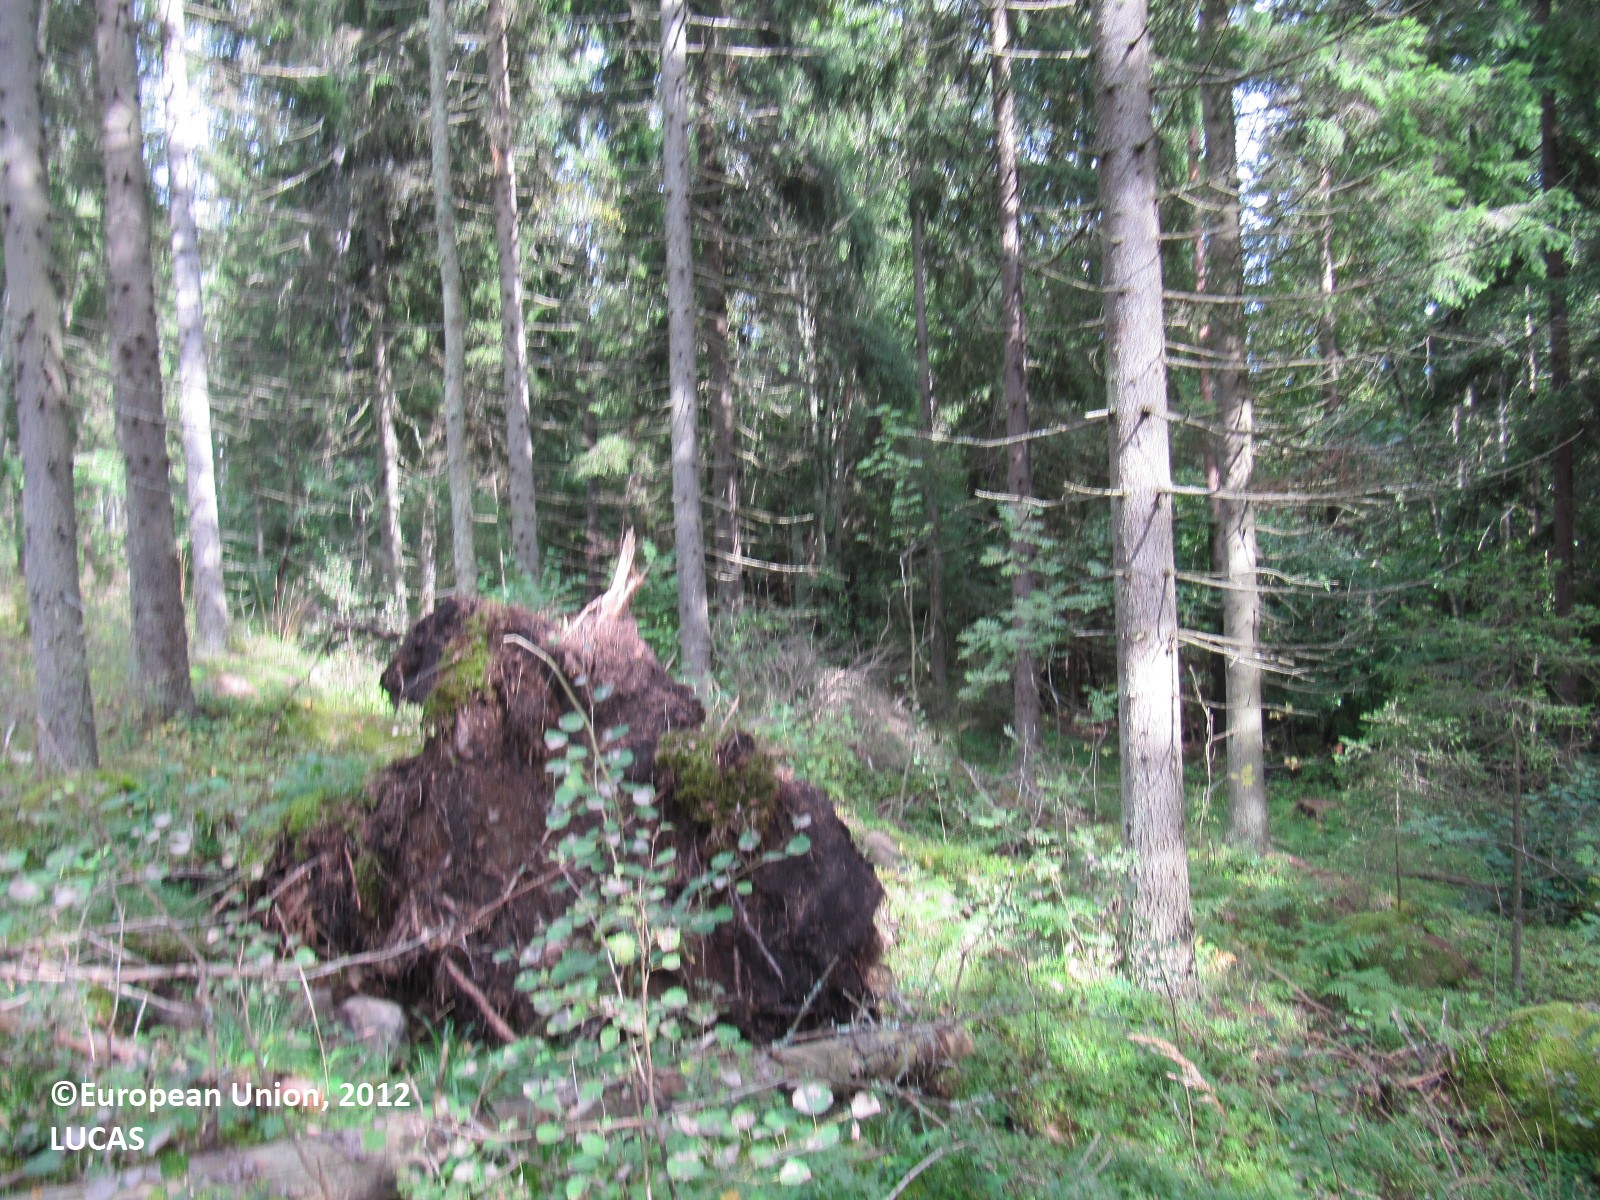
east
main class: Woodland
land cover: Spruce dominated mixed woodland
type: boreal forest
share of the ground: 50 - 75 %
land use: Forestry
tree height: > 5 m
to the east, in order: Spruce dominated mixed woodland; Ditches and canals; Grass margins; Tracks; Spontaneously vegetated surfaces; Ditches and canals; Other mixed woodland
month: August
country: FI
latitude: 60.2166
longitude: 24.1240
